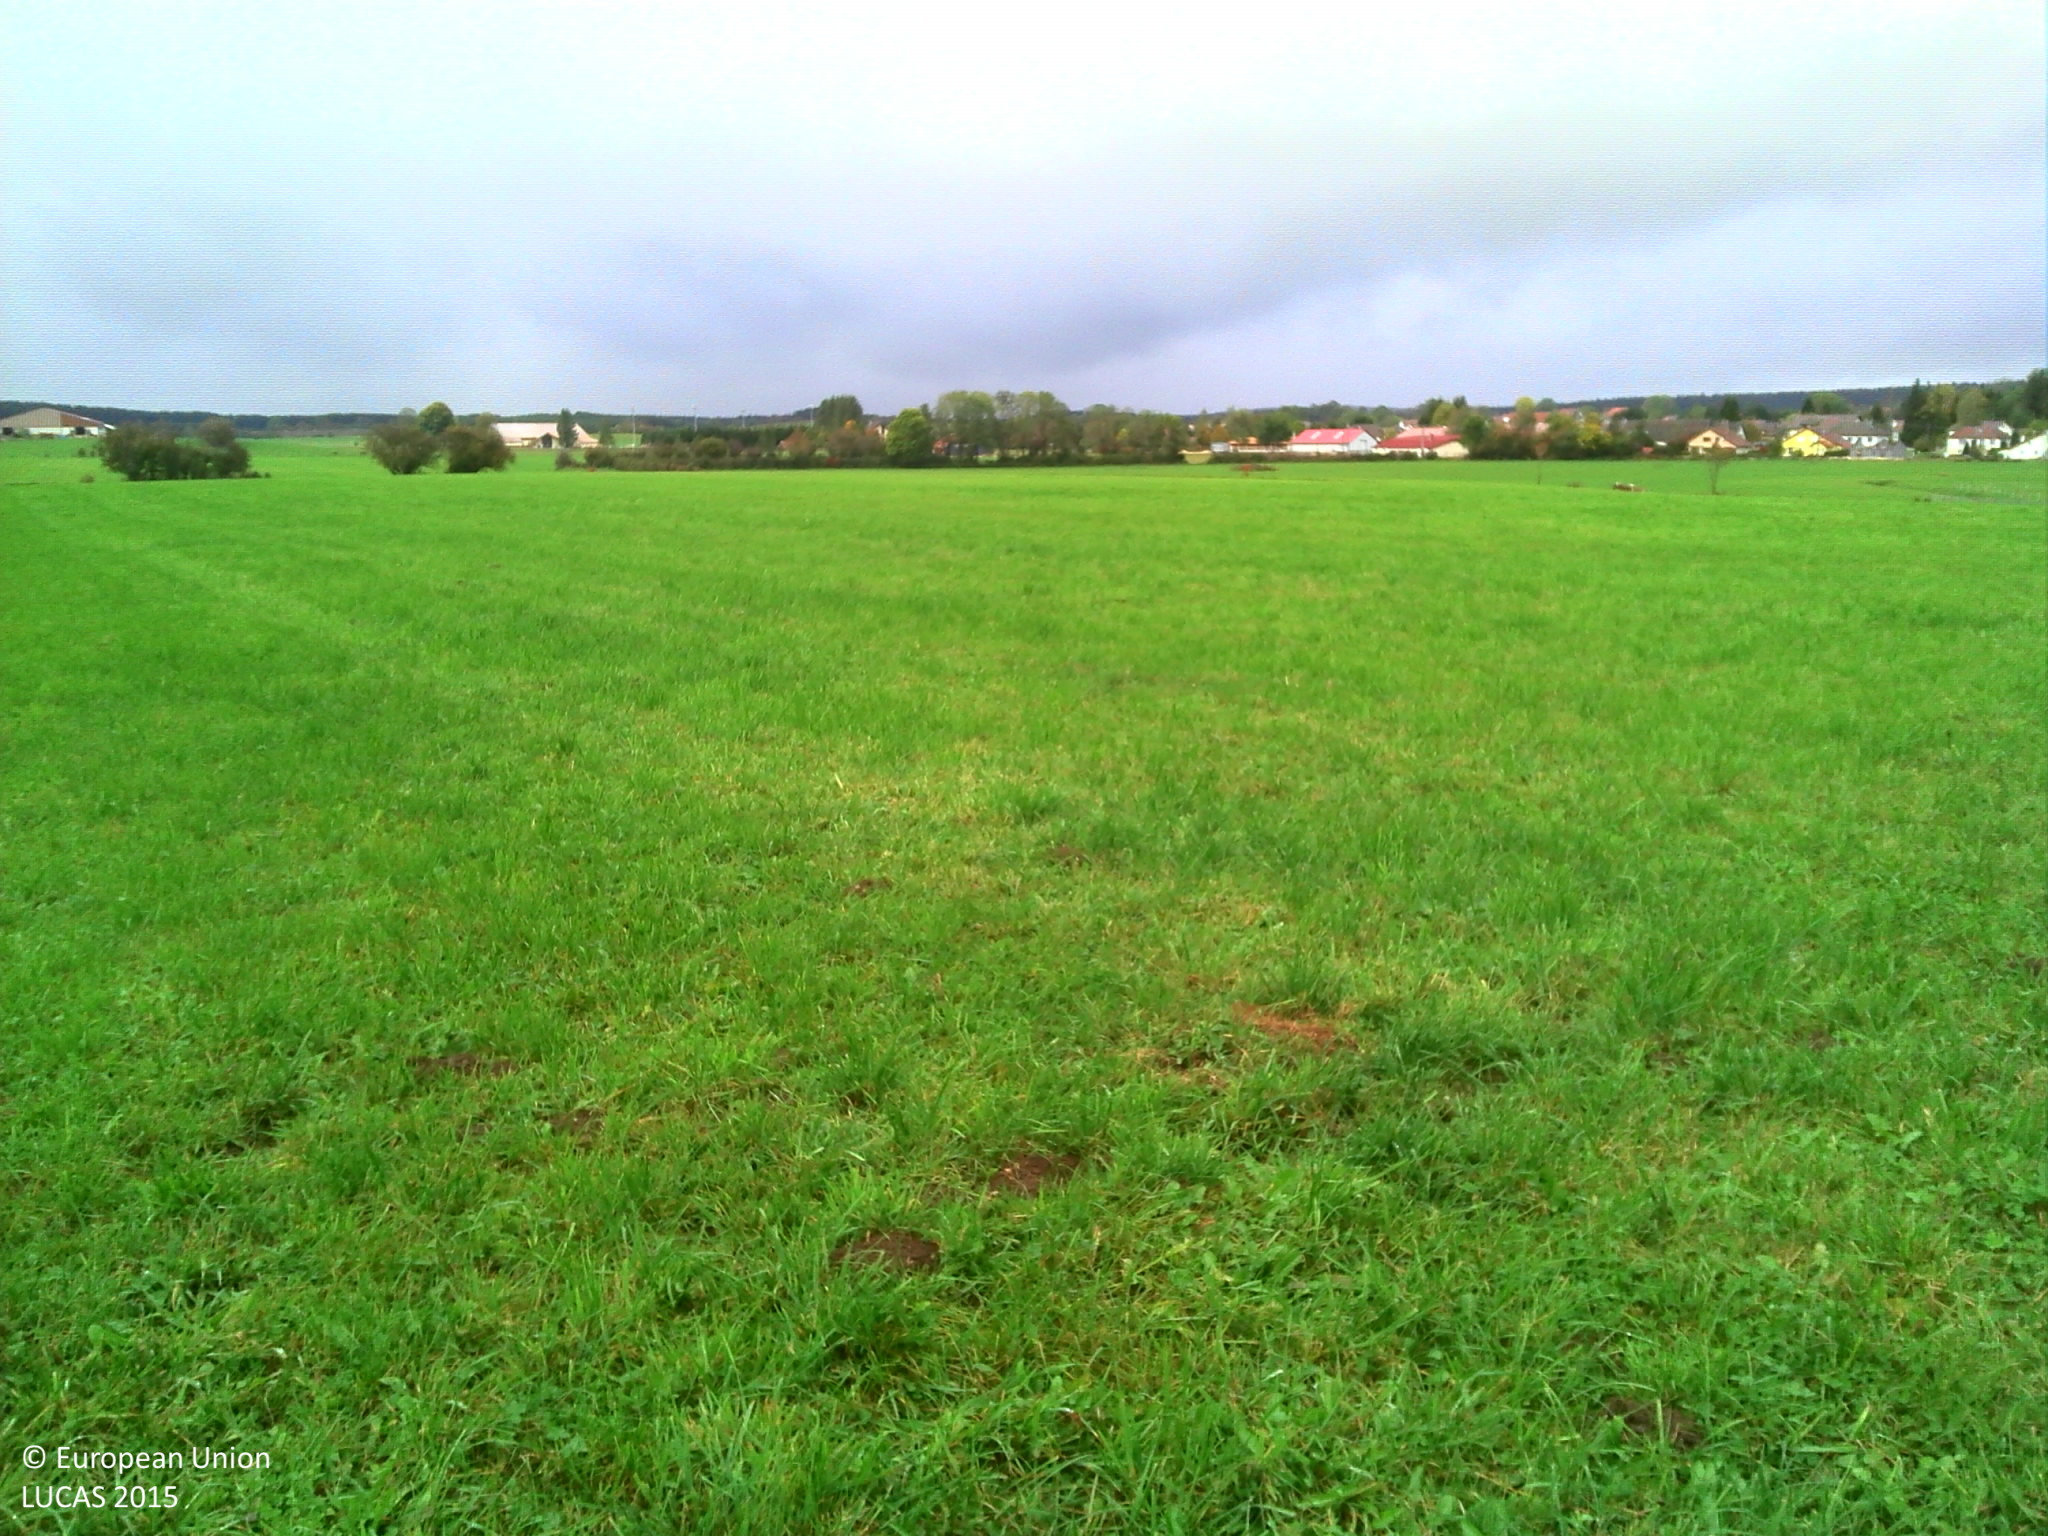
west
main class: Grassland
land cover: Grassland without tree/shrub cover
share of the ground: > 75 %
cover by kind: herbaceous plants 100 %
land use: Agriculture (excluding fallow land and kitchen gardens)
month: October
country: FR
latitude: 46.9481
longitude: 6.1264
